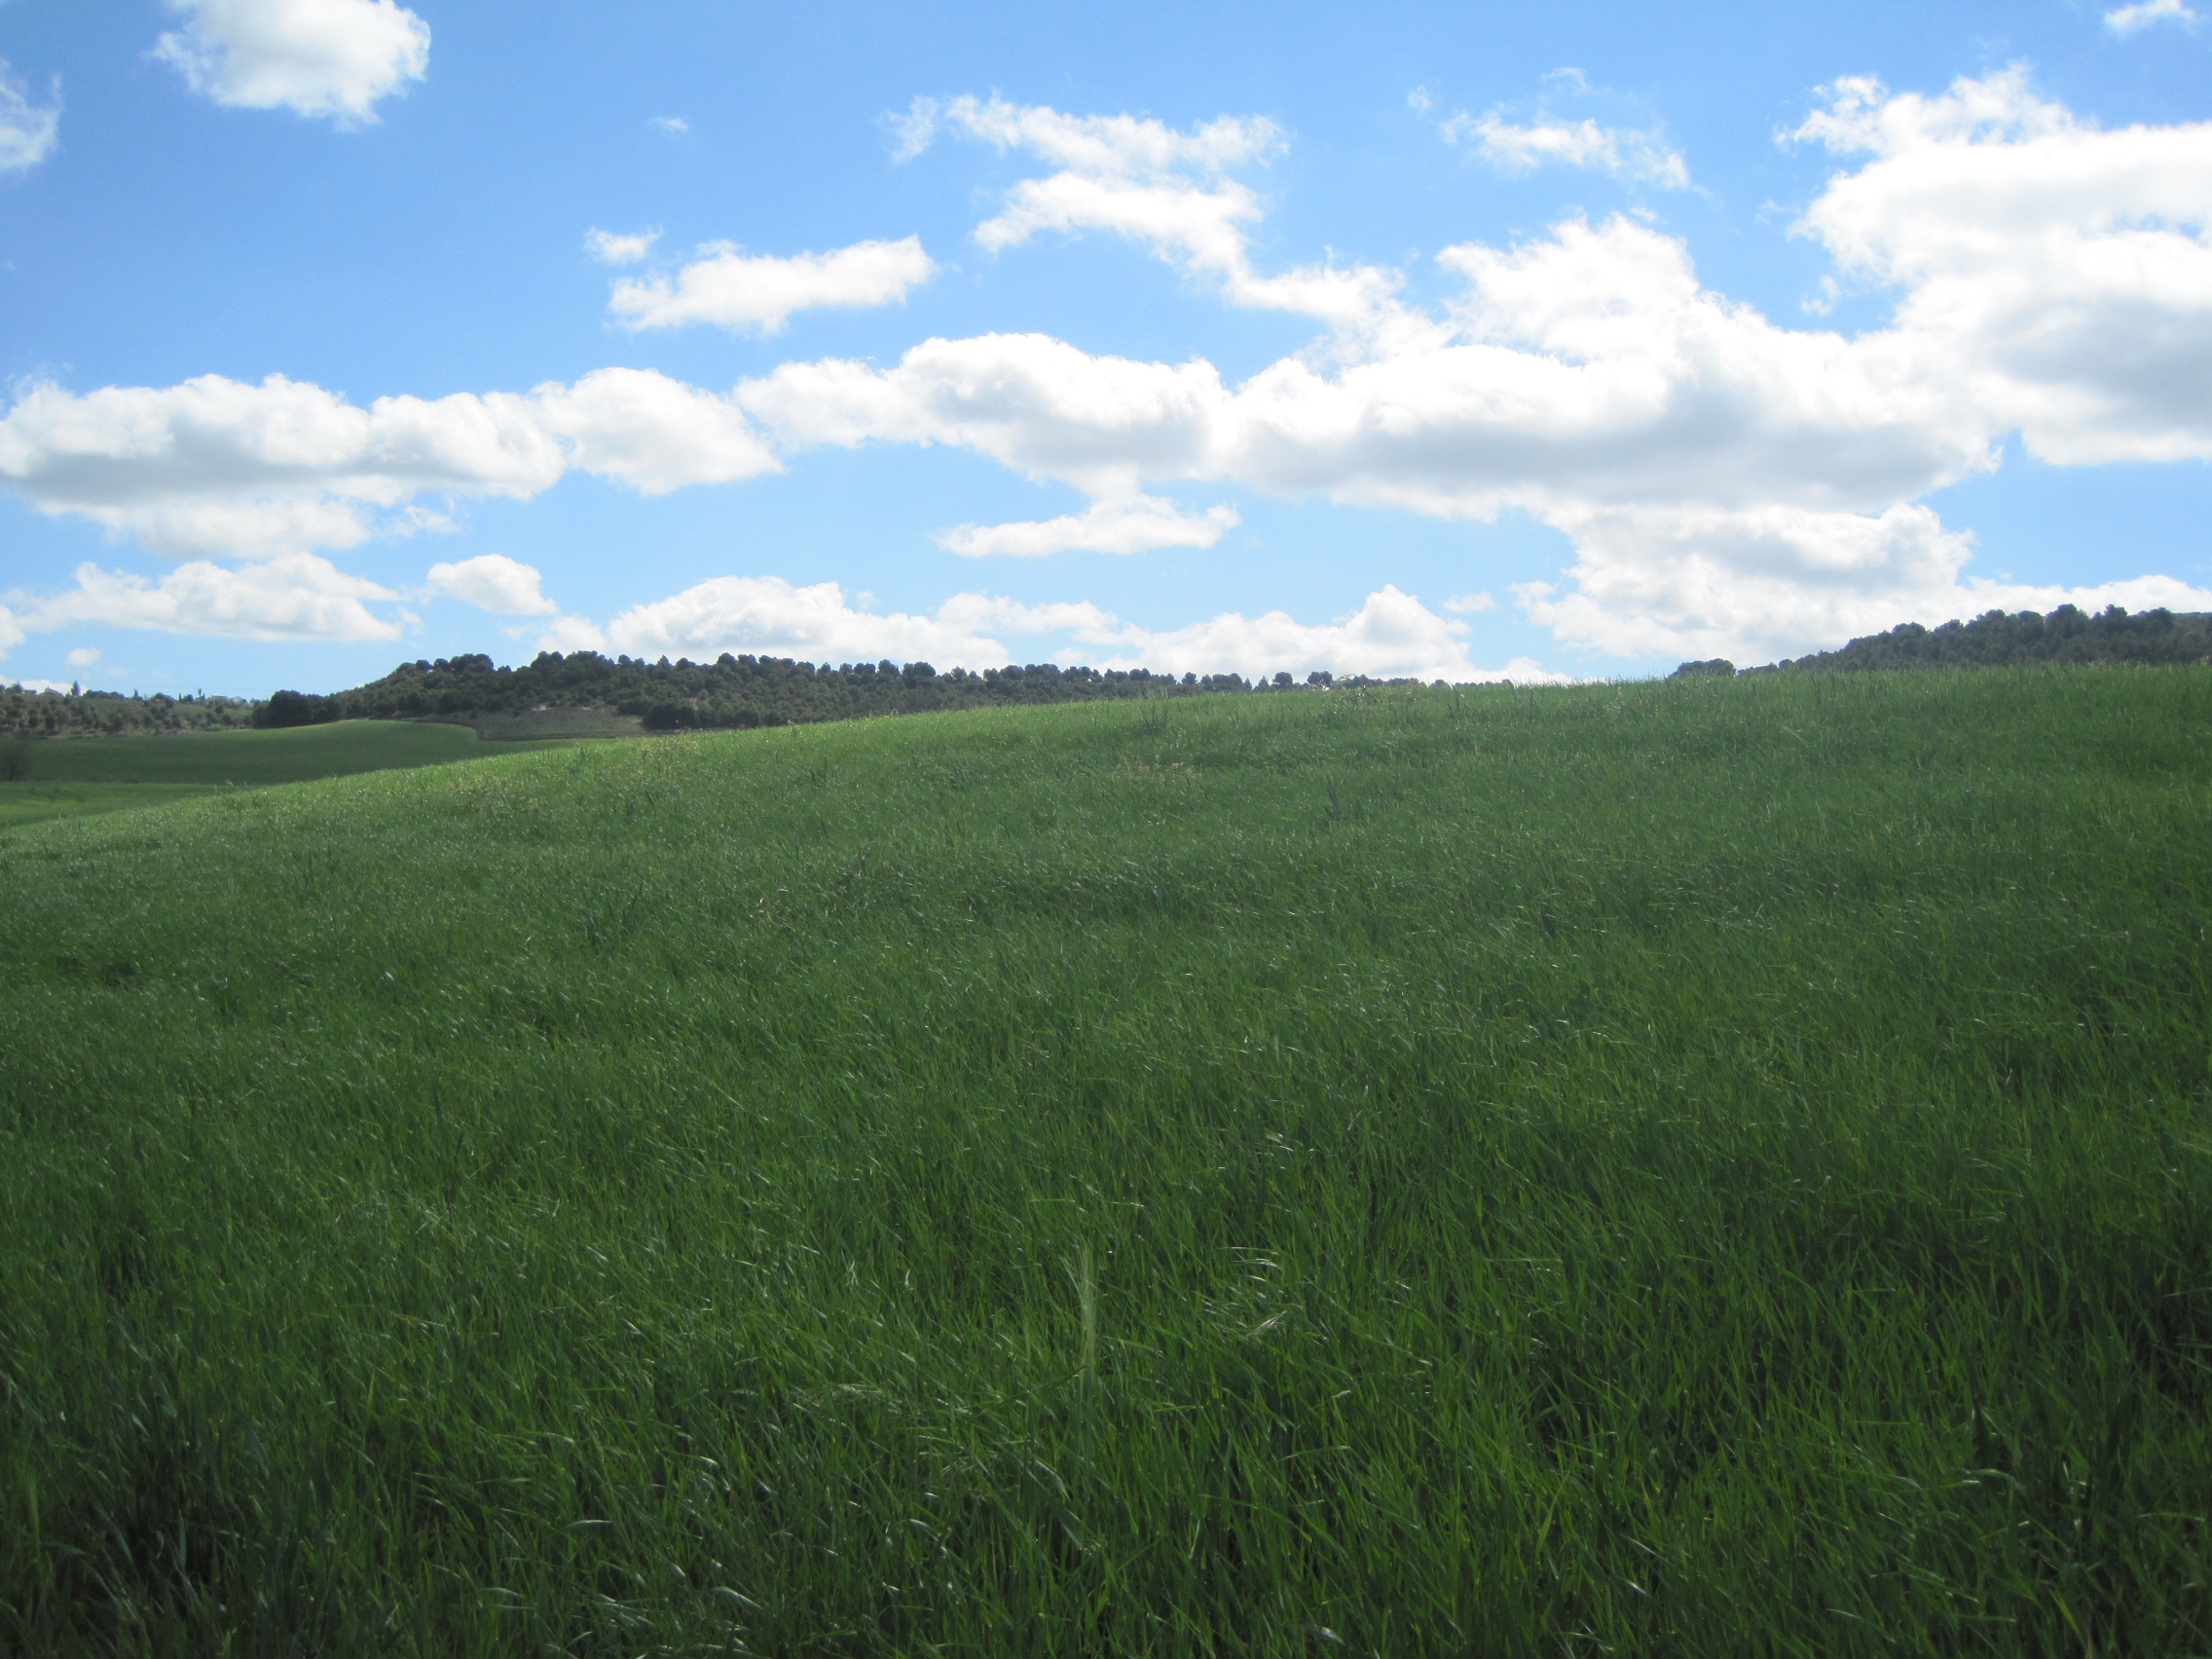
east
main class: Cropland
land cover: Barley
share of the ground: > 75 %
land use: Agriculture (excluding fallow land and kitchen gardens)
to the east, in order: Barley
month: May
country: ES
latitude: 41.6155
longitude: -4.6727
